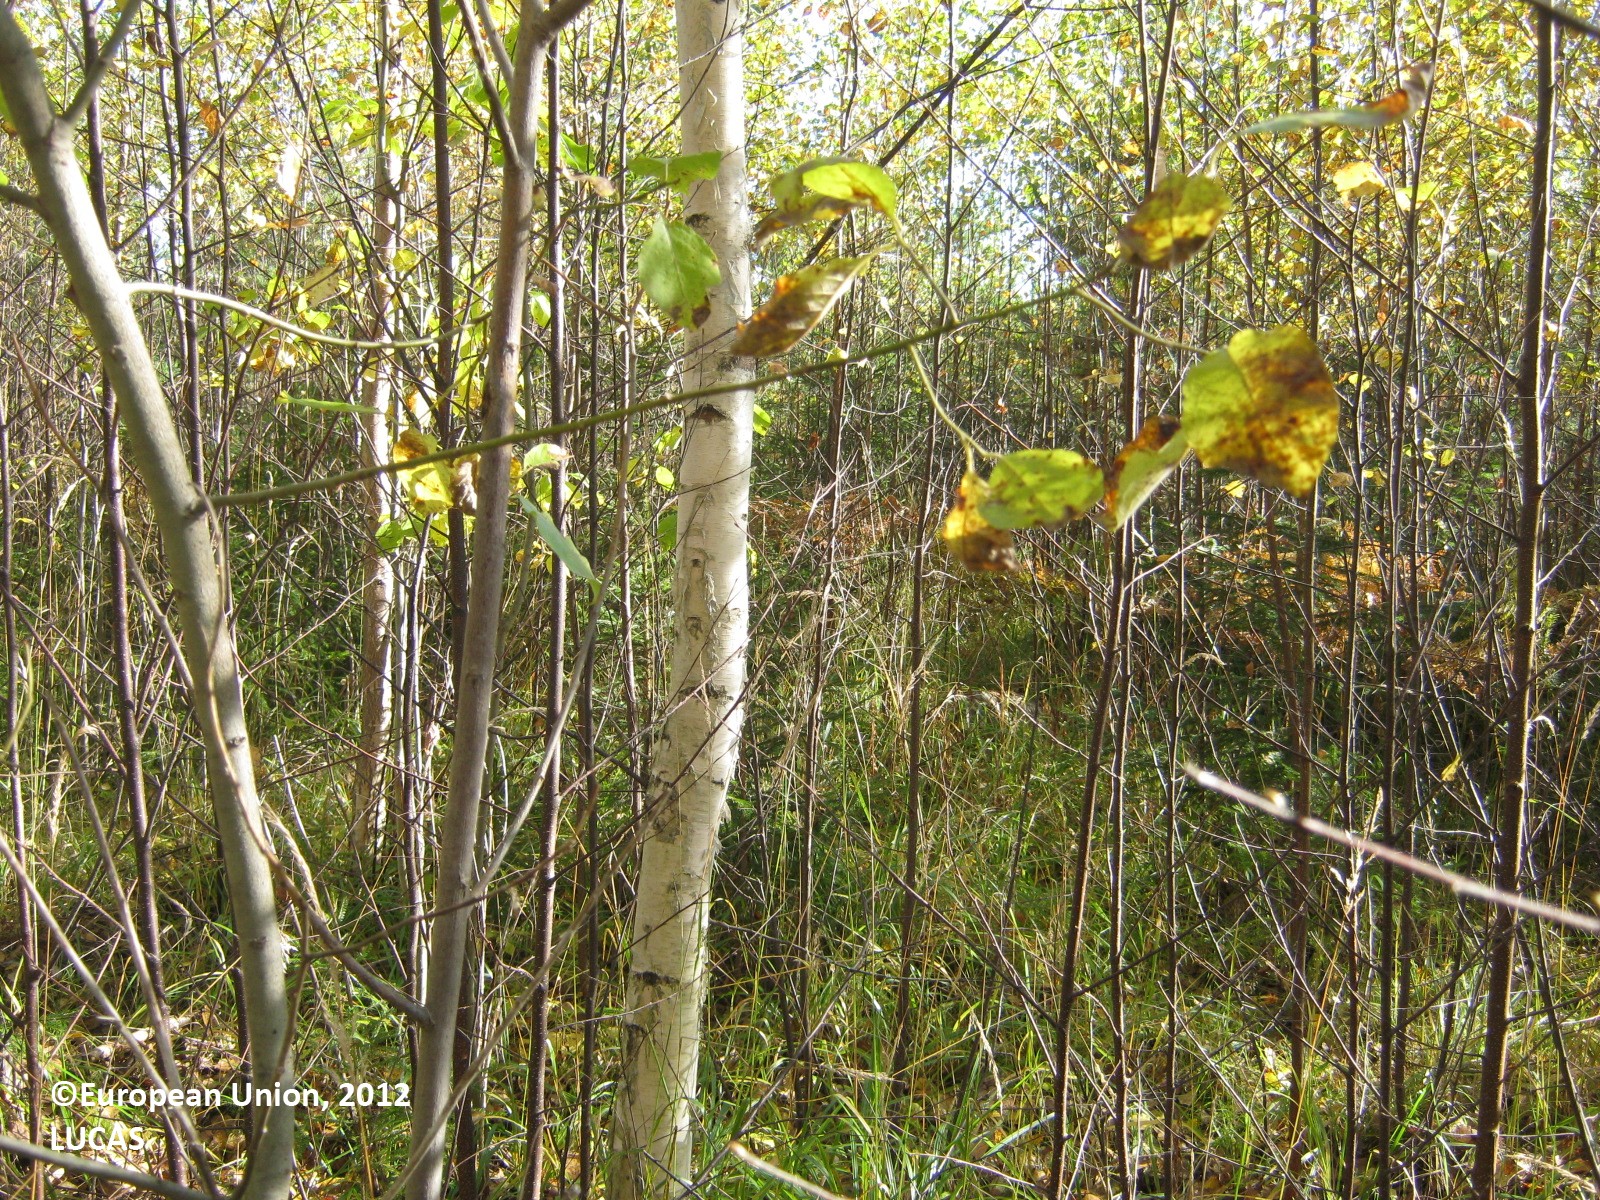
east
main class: Woodland
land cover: Broadleaved woodland
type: boreal forest
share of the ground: > 75 %
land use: Forestry
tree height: > 5 m
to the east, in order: Broadleaved woodland; Other mixed woodland; Shrubland with sparse tree cover; Other mixed woodland
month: September
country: FI
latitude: 62.3973
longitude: 28.8052
